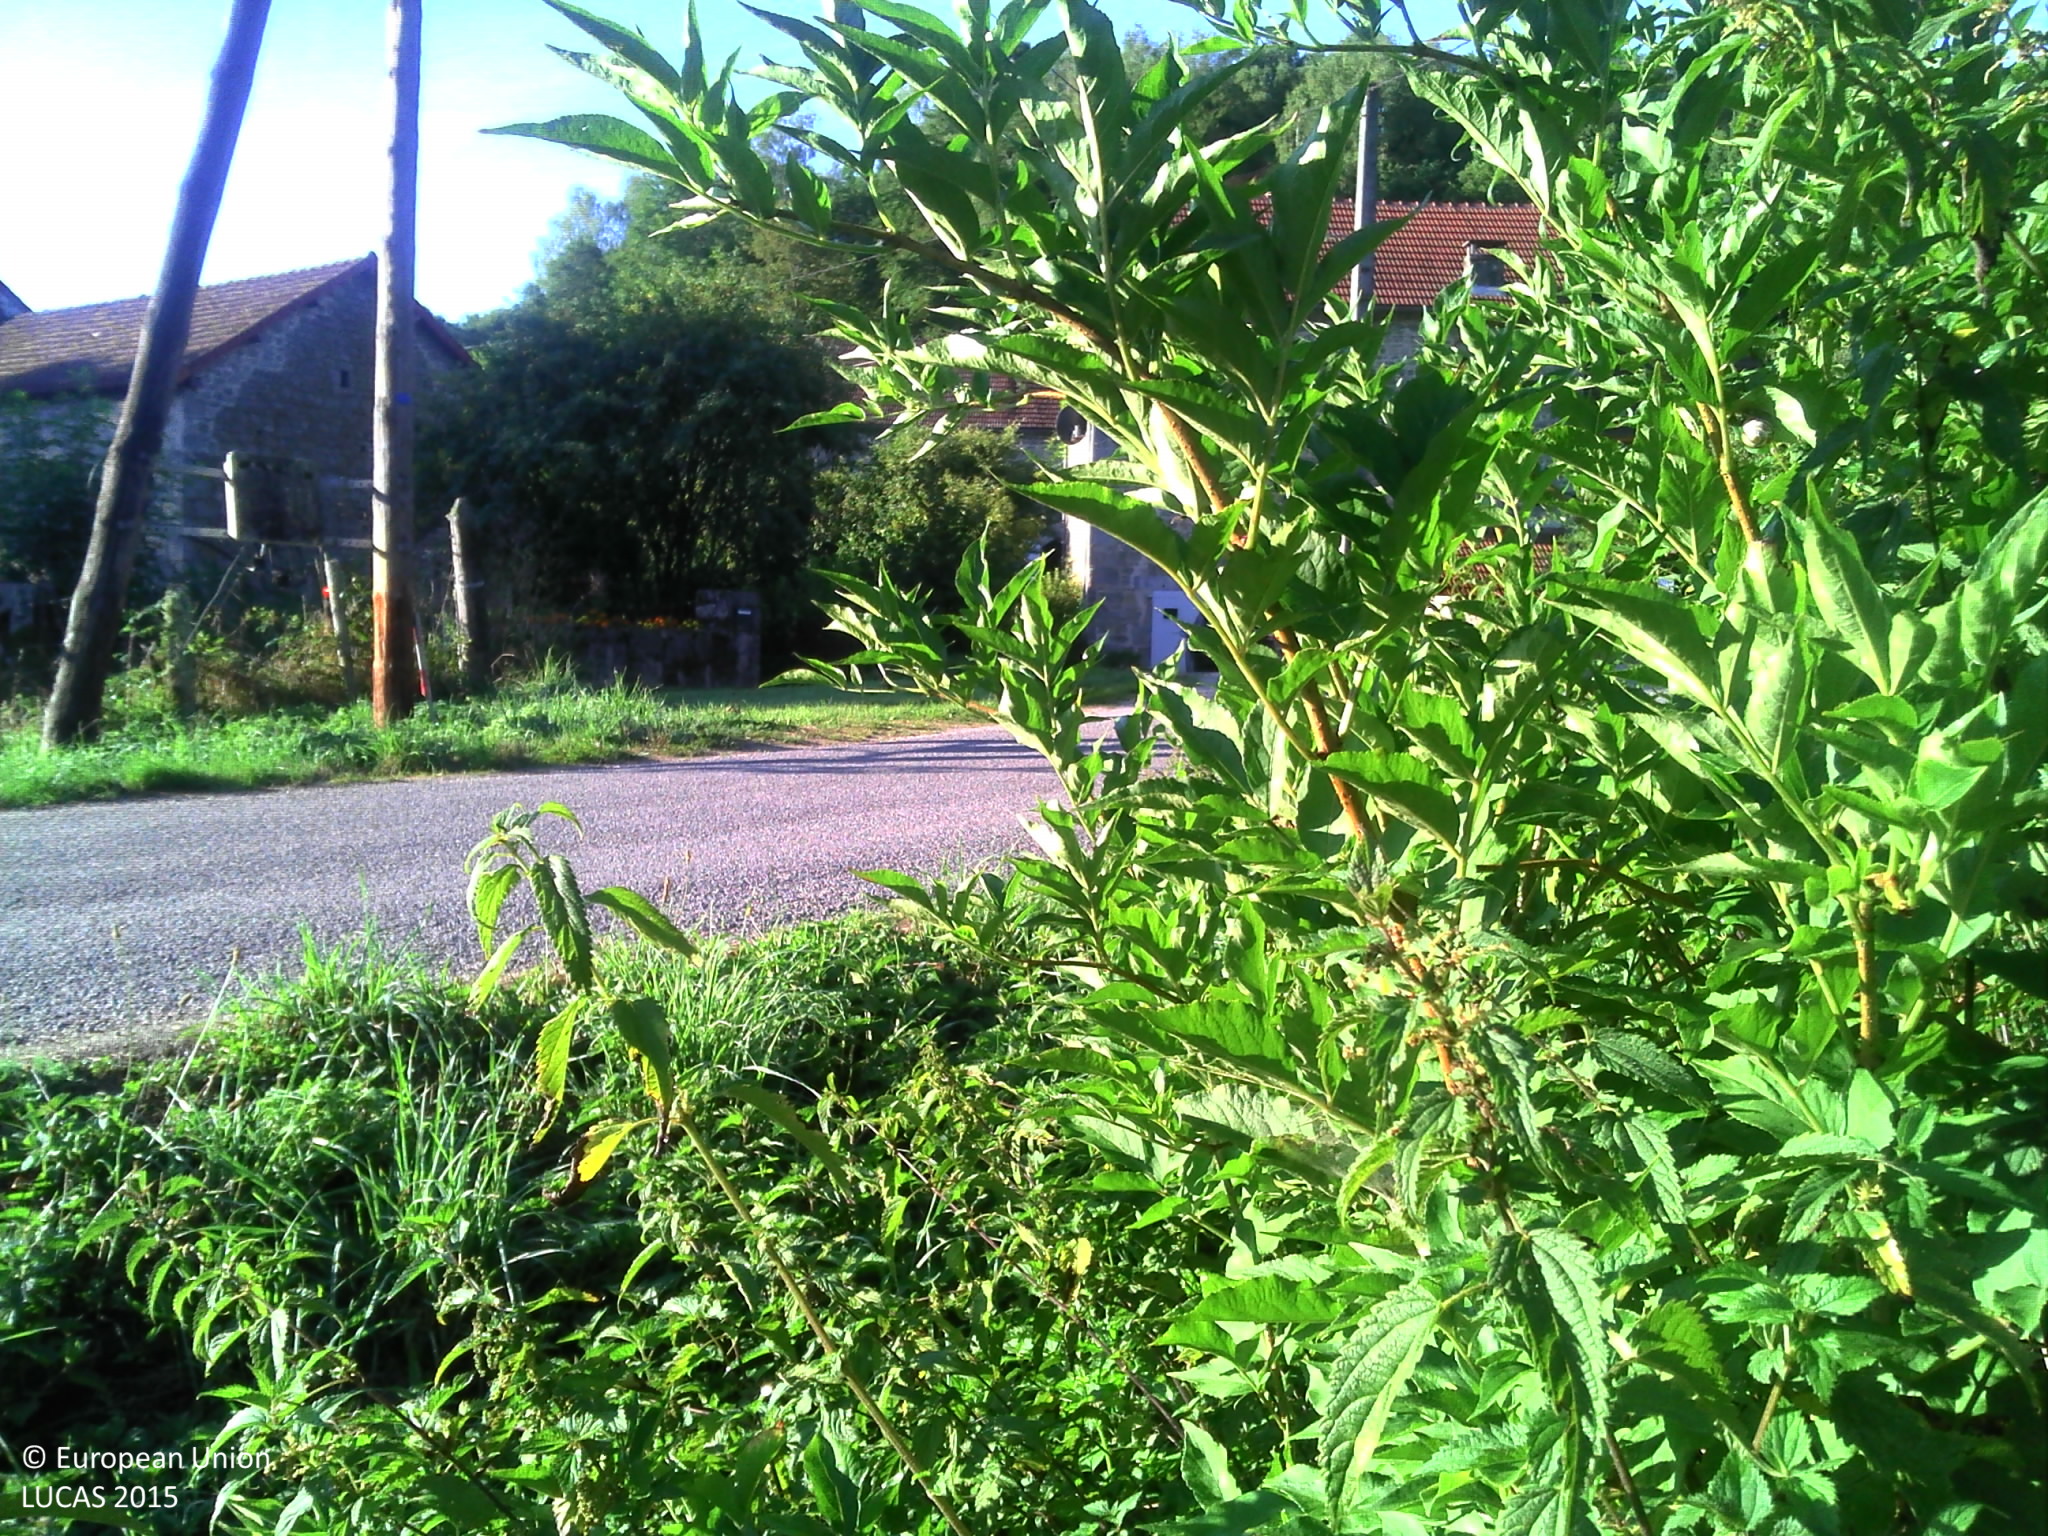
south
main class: Shrubland
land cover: Shrubland with sparse tree cover
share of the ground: > 75 %
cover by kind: herbaceous plants 55 %, shrubs 40 %, broadleaved forest trees 5 %
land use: Semi-natural and natural areas not in use
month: August
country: FR
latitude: 45.8389
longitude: 2.3100
